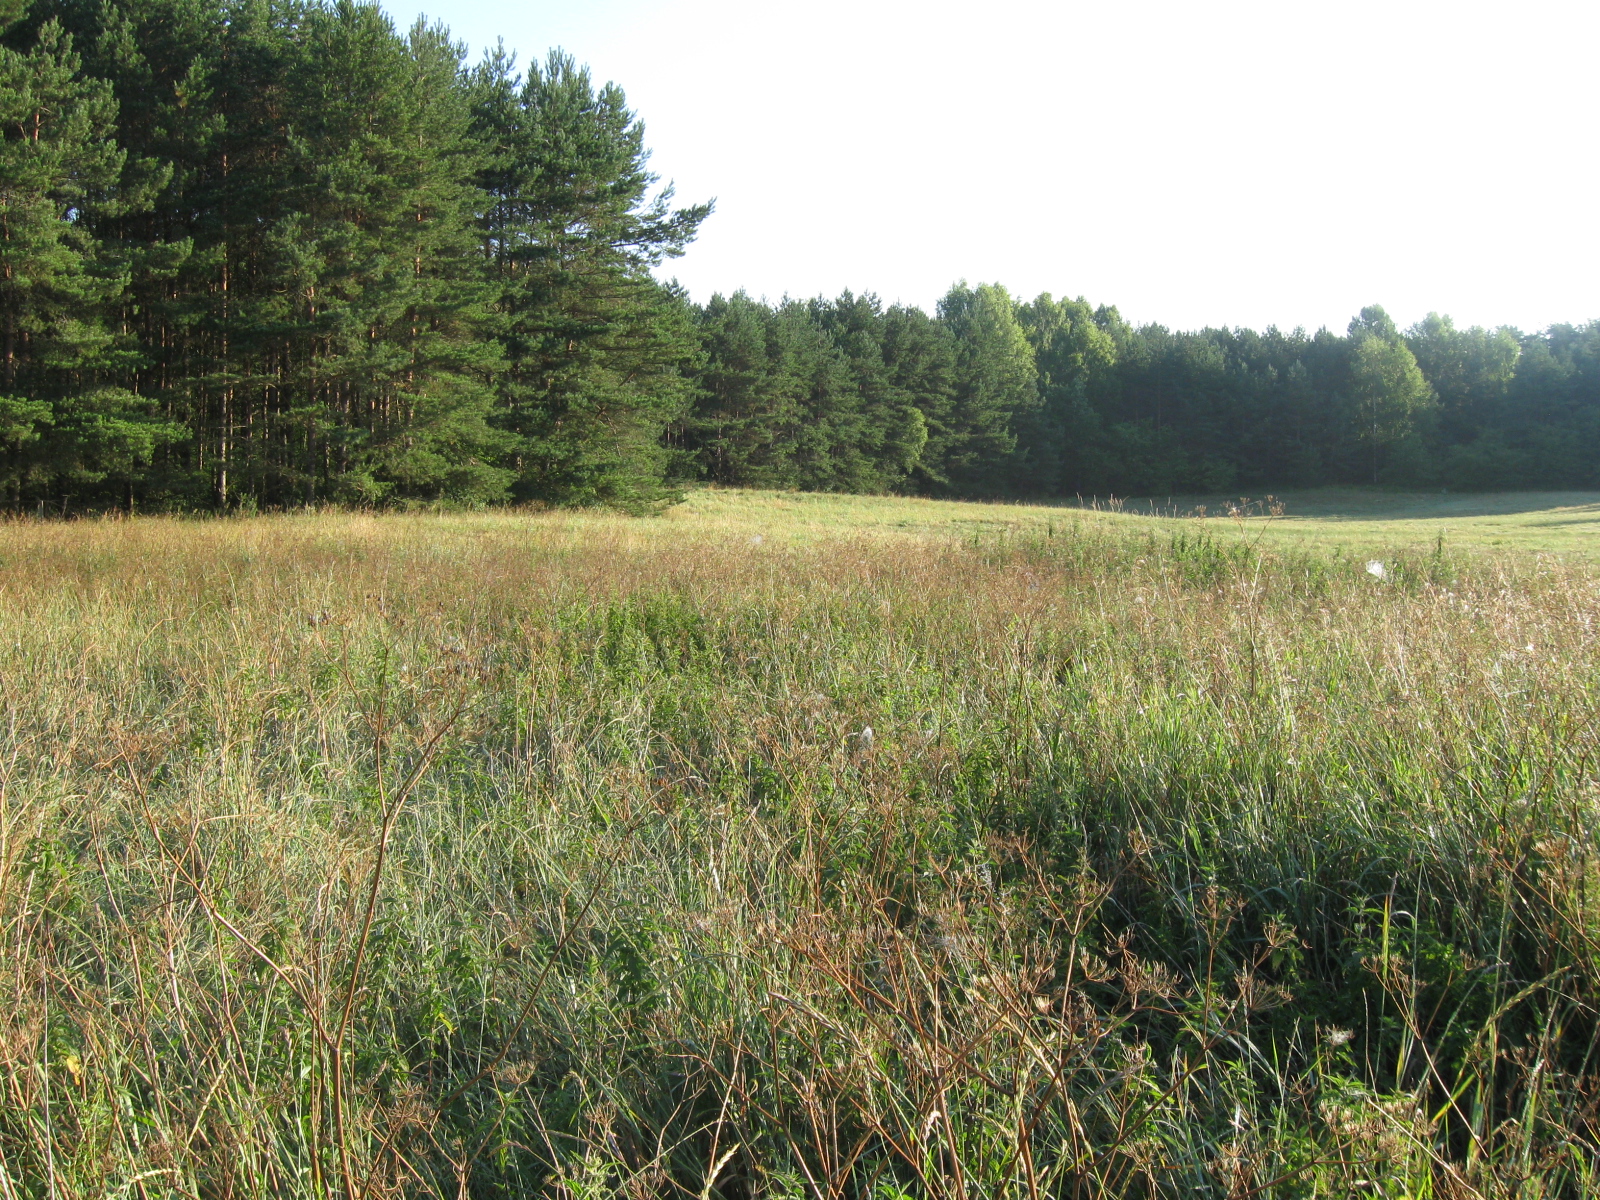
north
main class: Grassland
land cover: Grassland without tree/shrub cover
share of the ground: > 75 %
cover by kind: herbaceous plants 100 %
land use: Agriculture (excluding fallow land and kitchen gardens)
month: July
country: LT
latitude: 54.1382
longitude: 23.8189
